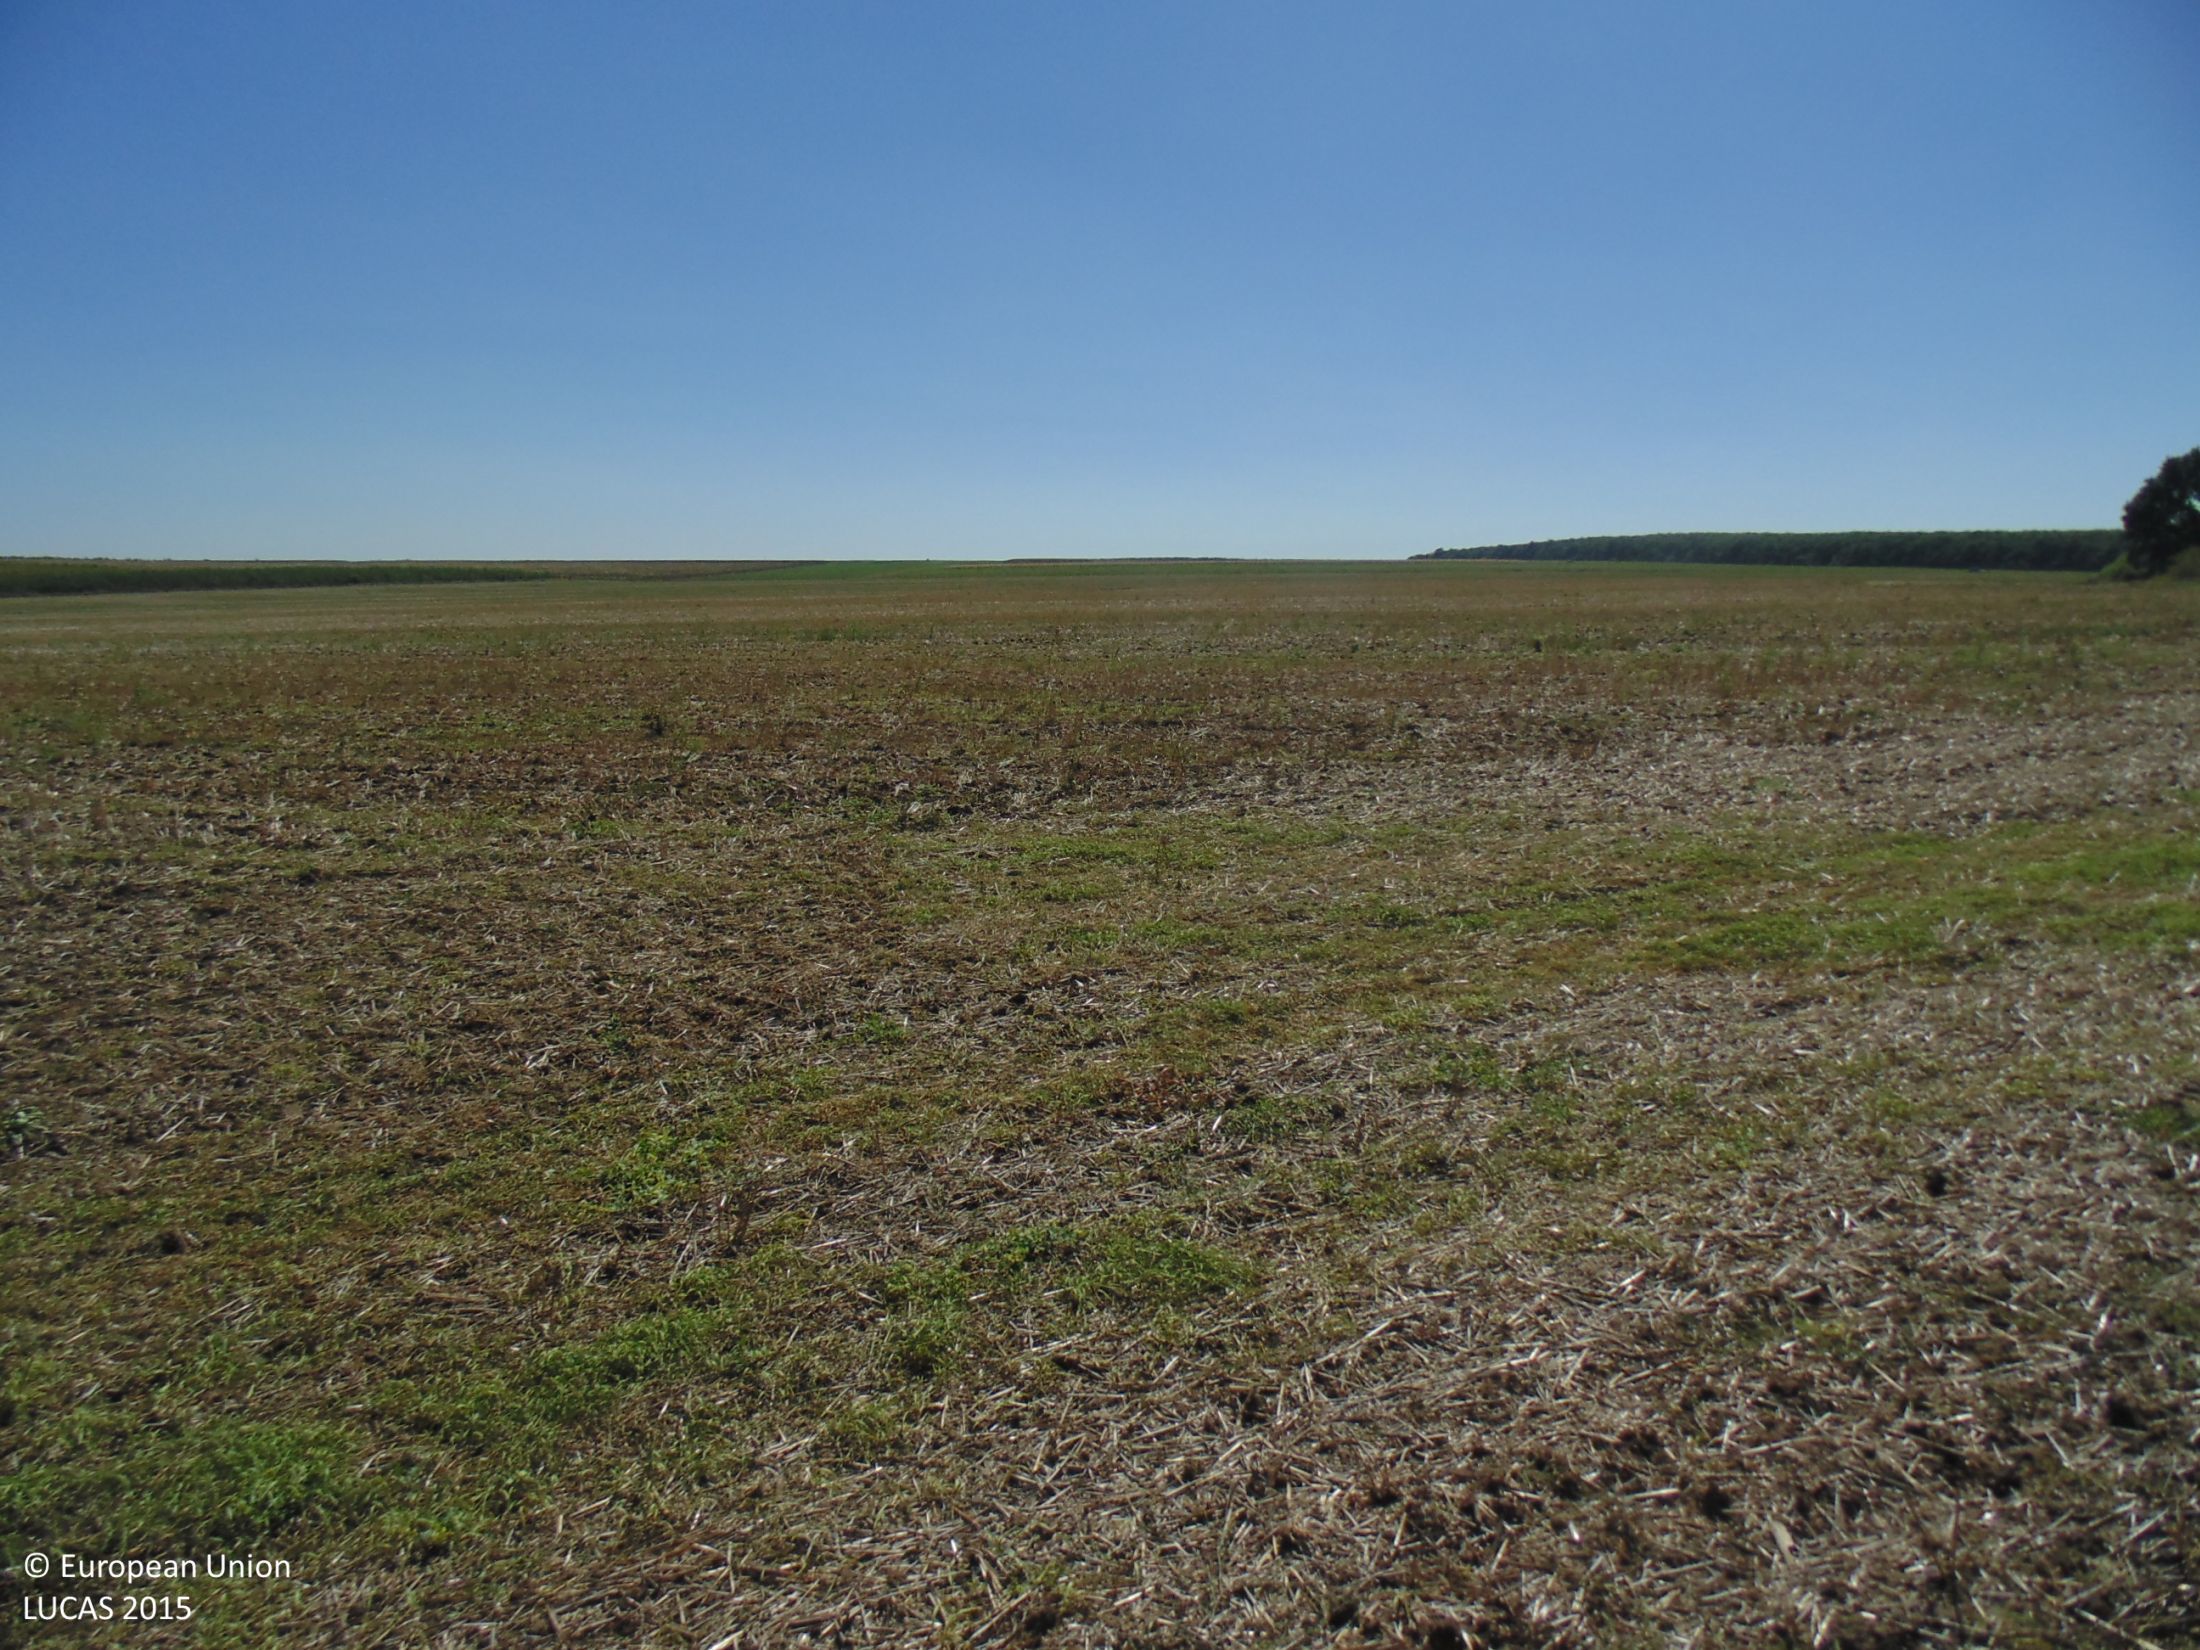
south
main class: Cropland
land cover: Common wheat
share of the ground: < 10 %
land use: Agriculture (excluding fallow land and kitchen gardens)
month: September
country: BG
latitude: 43.7333
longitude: 27.0691
